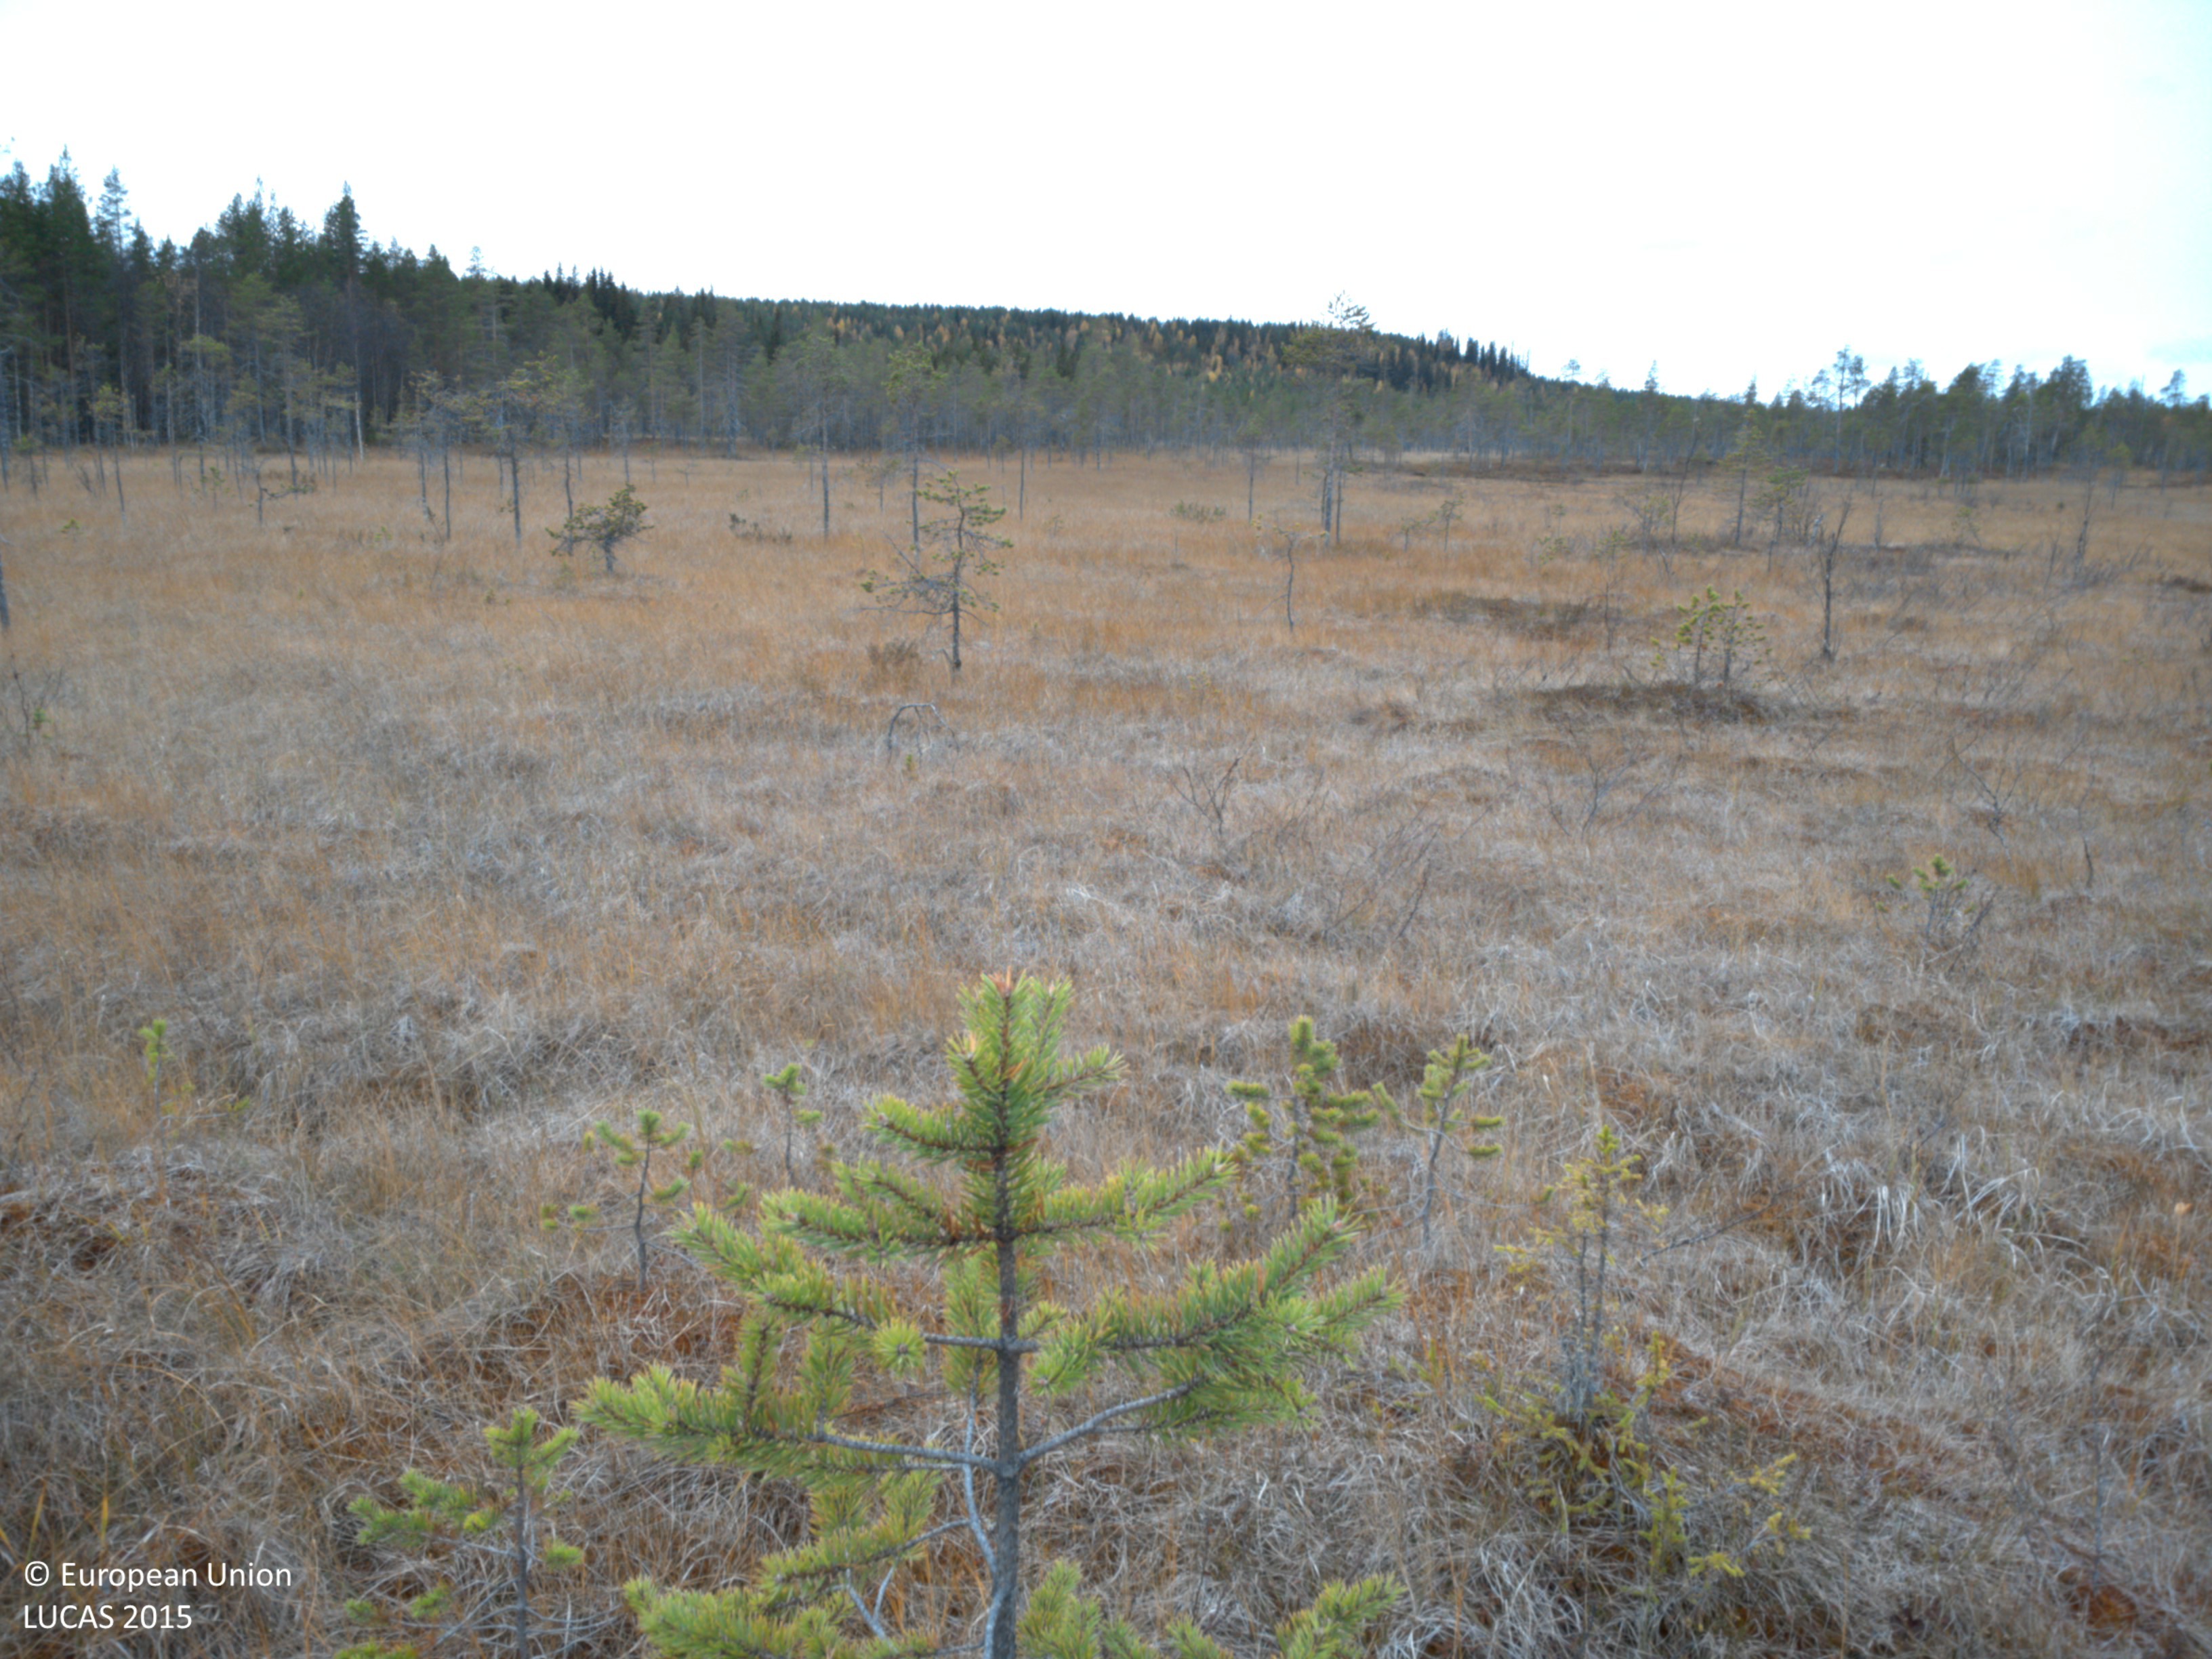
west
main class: Woodland
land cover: Pine dominated coniferous woodland
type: boreal forest
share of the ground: 10 - 25 %
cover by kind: herbaceous plants 45 %, shrubs 25 %, coniferous forest trees 15 %, lichens and mosses 15 %
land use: Semi-natural and natural areas not in use
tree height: < 5 m
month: October
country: SE
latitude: 65.0211
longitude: 18.2196
